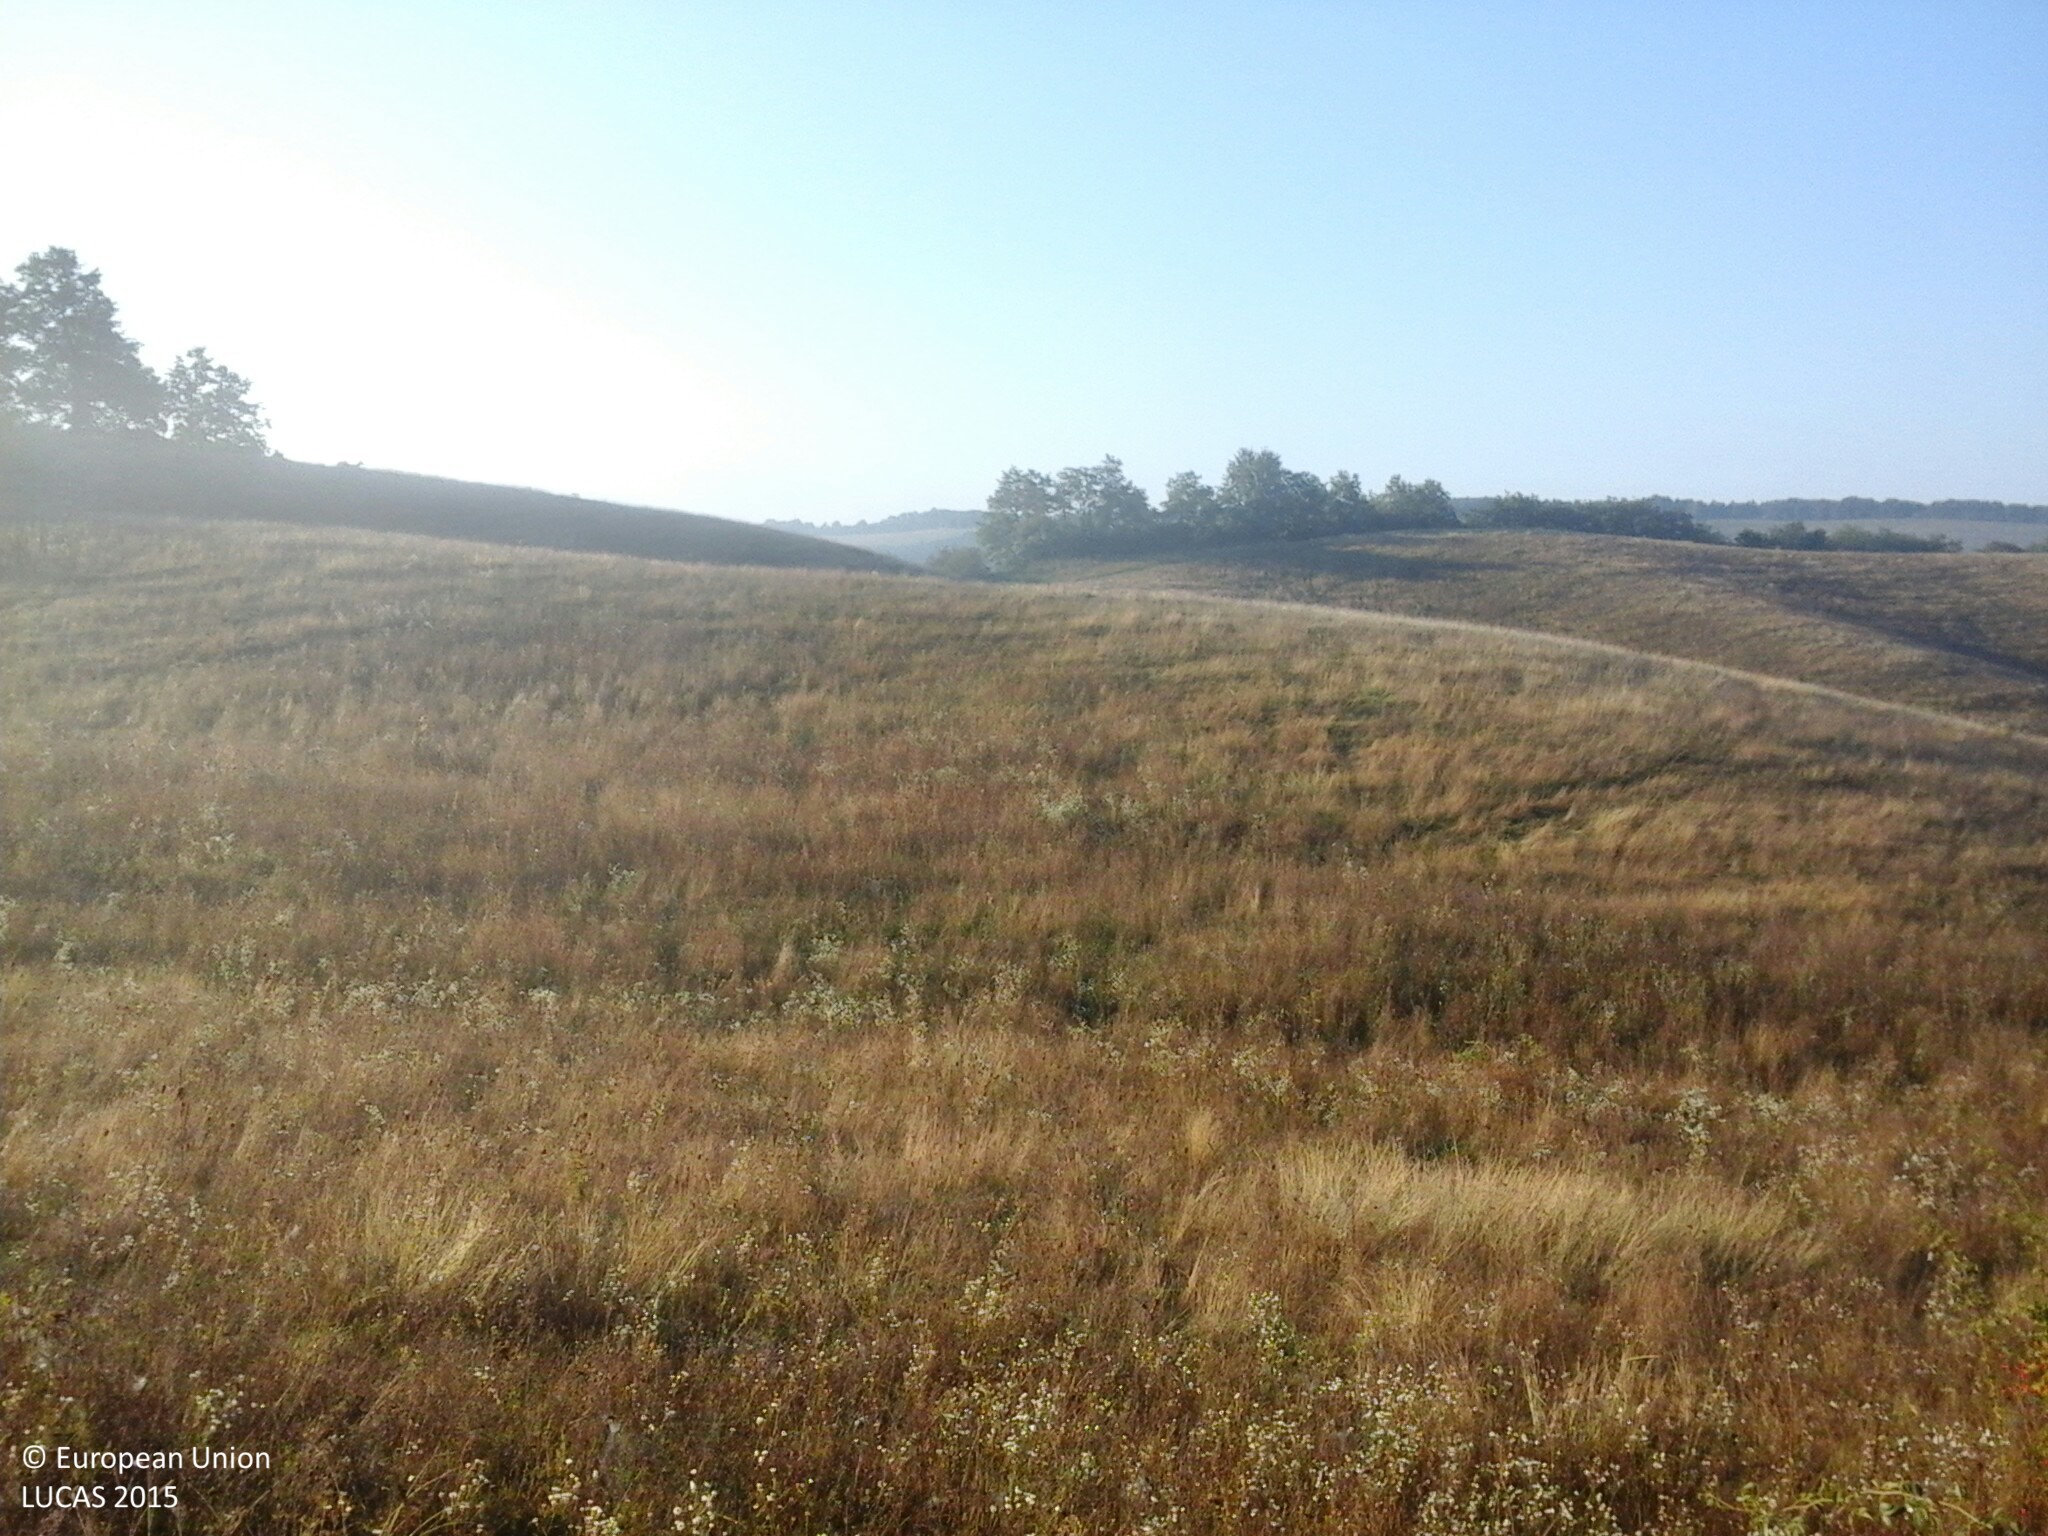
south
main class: Grassland
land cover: Spontaneously vegetated surfaces
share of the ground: > 75 %
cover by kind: herbaceous plants 100 %
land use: Semi-natural and natural areas not in use
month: September
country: HU
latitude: 48.1649
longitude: 20.0186
